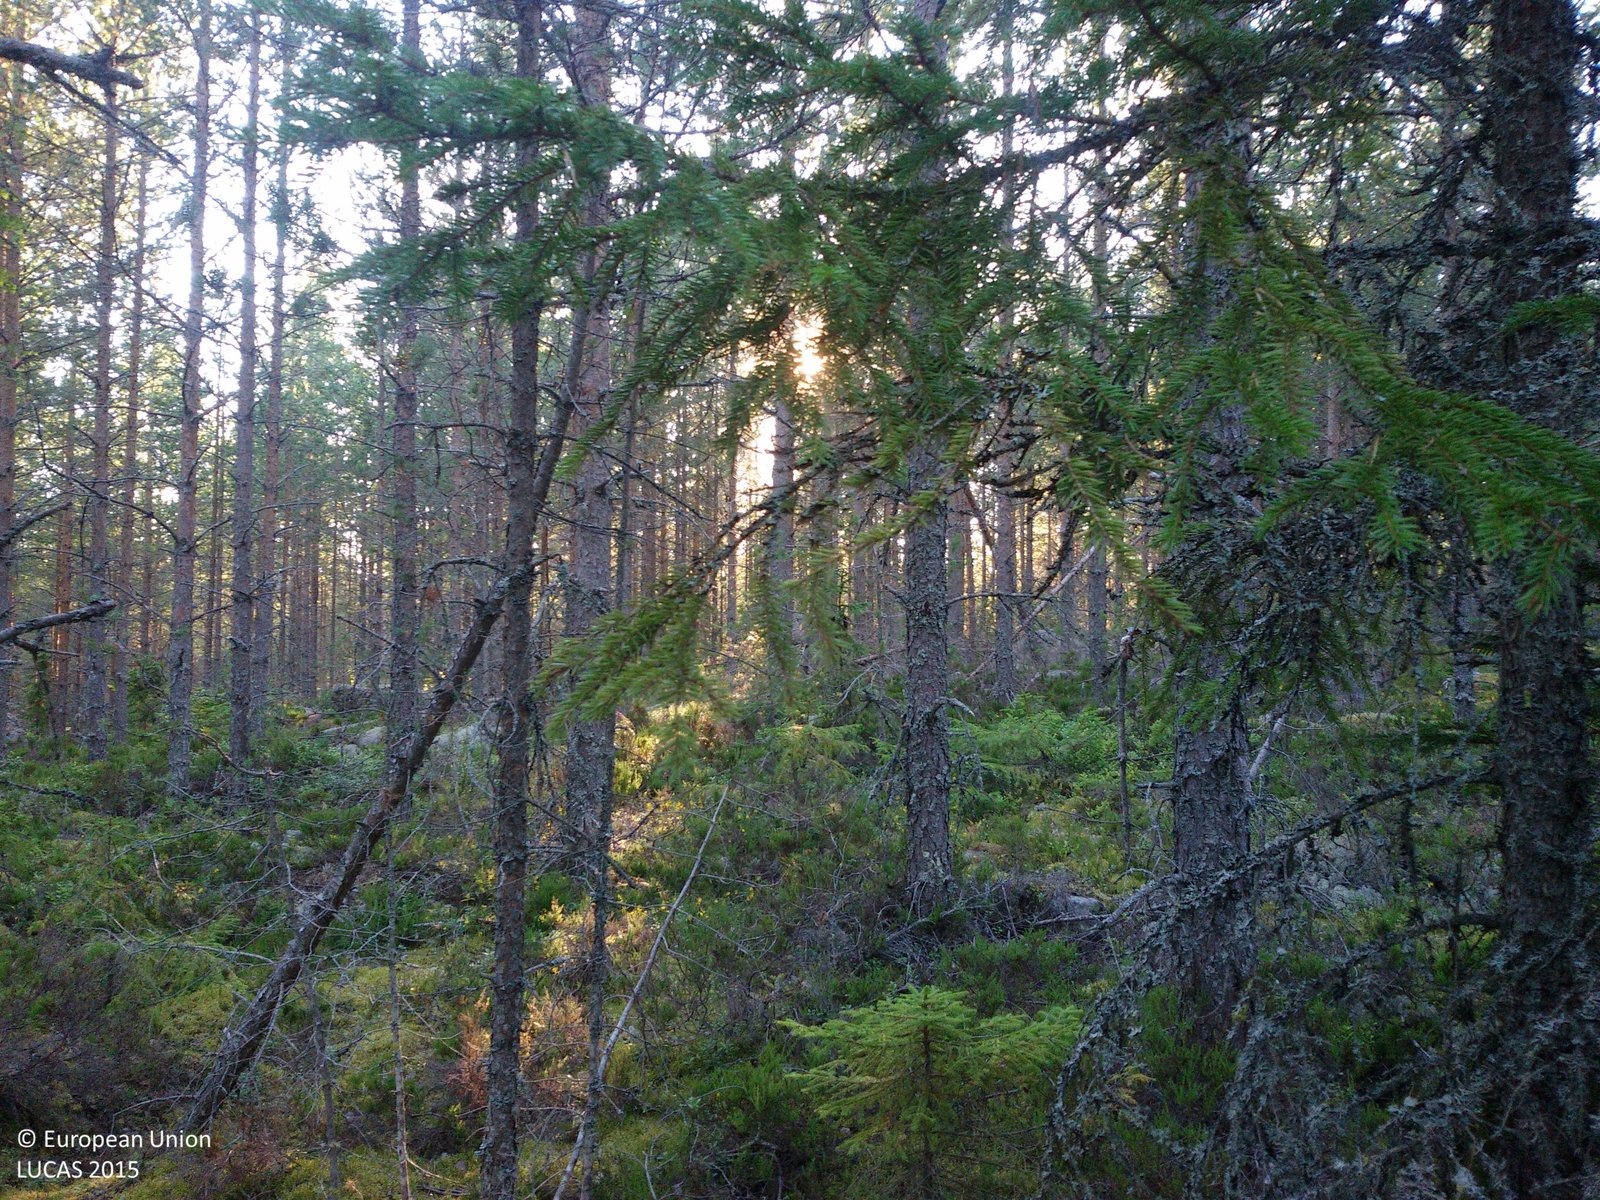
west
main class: Woodland
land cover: Pine dominated coniferous woodland
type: boreal forest
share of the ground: > 75 %
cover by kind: coniferous forest trees 90 %, shrubs 5 %, lichens and mosses 5 %
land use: Forestry
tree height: > 5 m
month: August
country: SE
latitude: 60.8791
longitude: 16.5264
